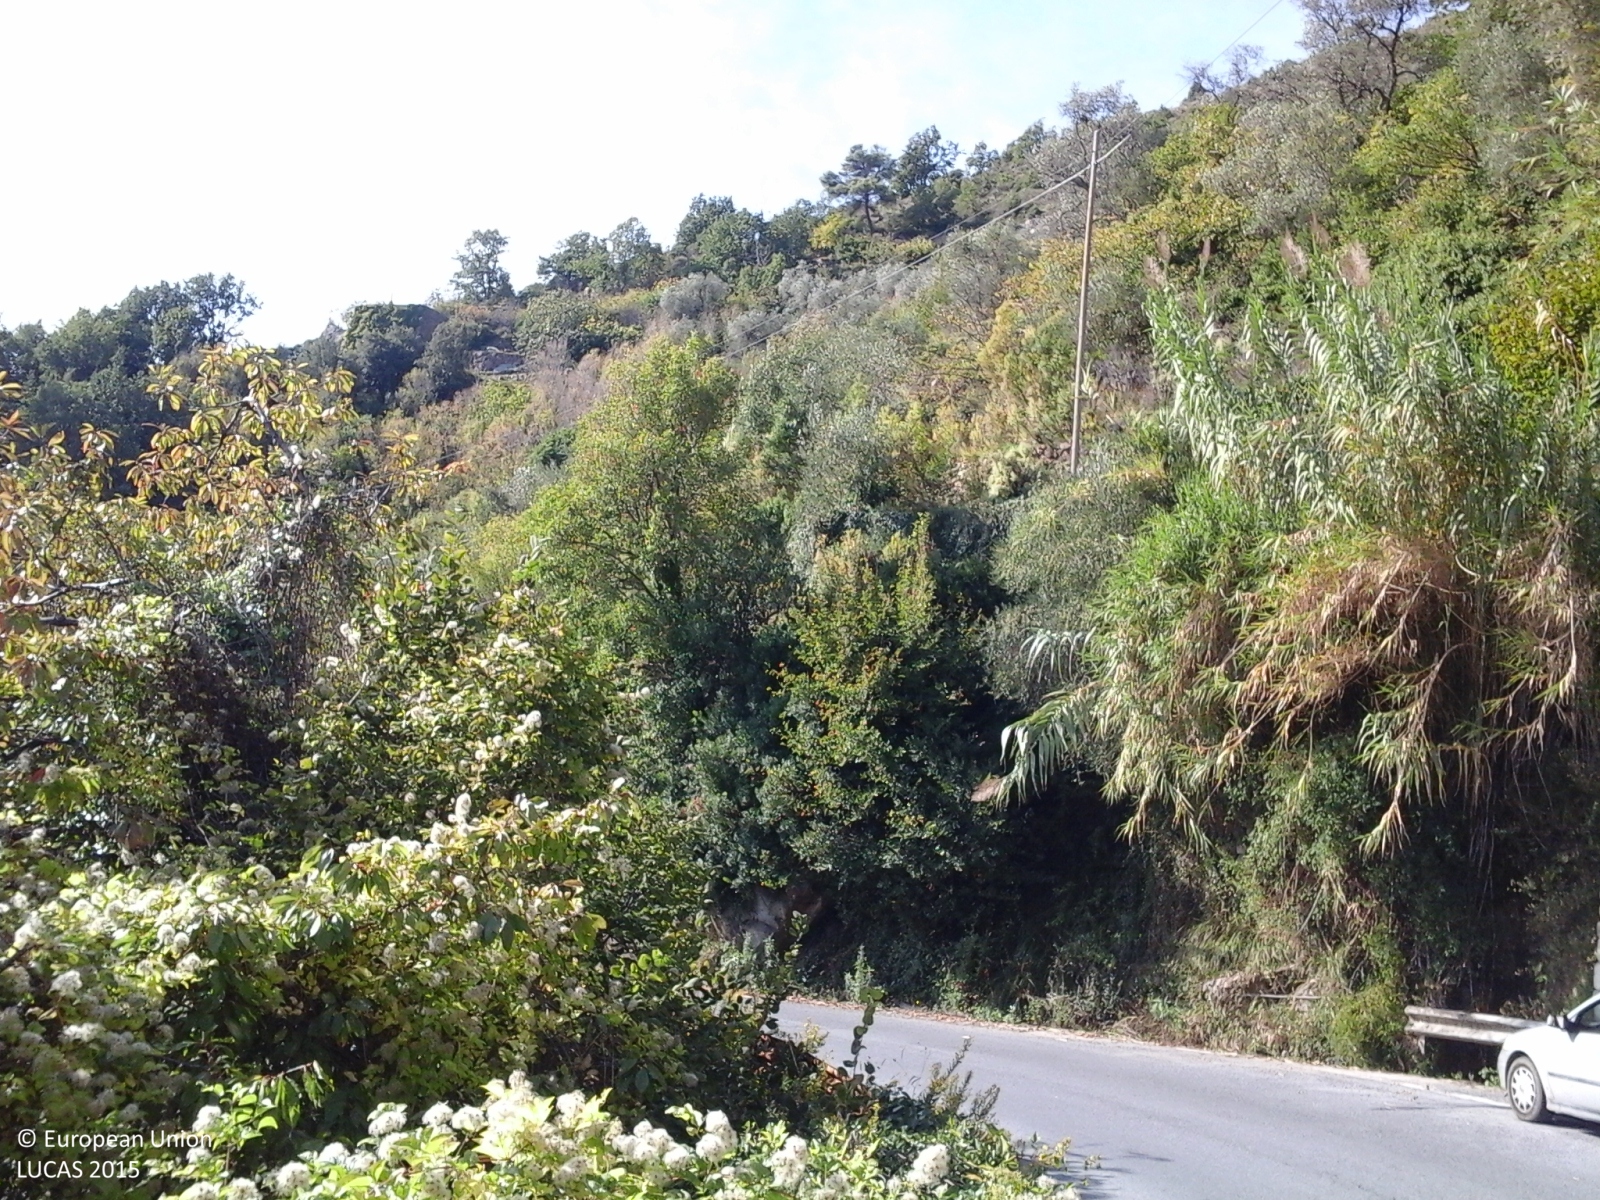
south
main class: Woodland
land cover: Broadleaved woodland
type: thermophilous deciduous forest
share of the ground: > 75 %
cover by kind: broadleaved forest trees 80 %, shrubs 10 %, herbaceous plants 10 %
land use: Semi-natural and natural areas not in use
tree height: > 5 m
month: October
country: IT
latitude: 43.8581
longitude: 7.8033
